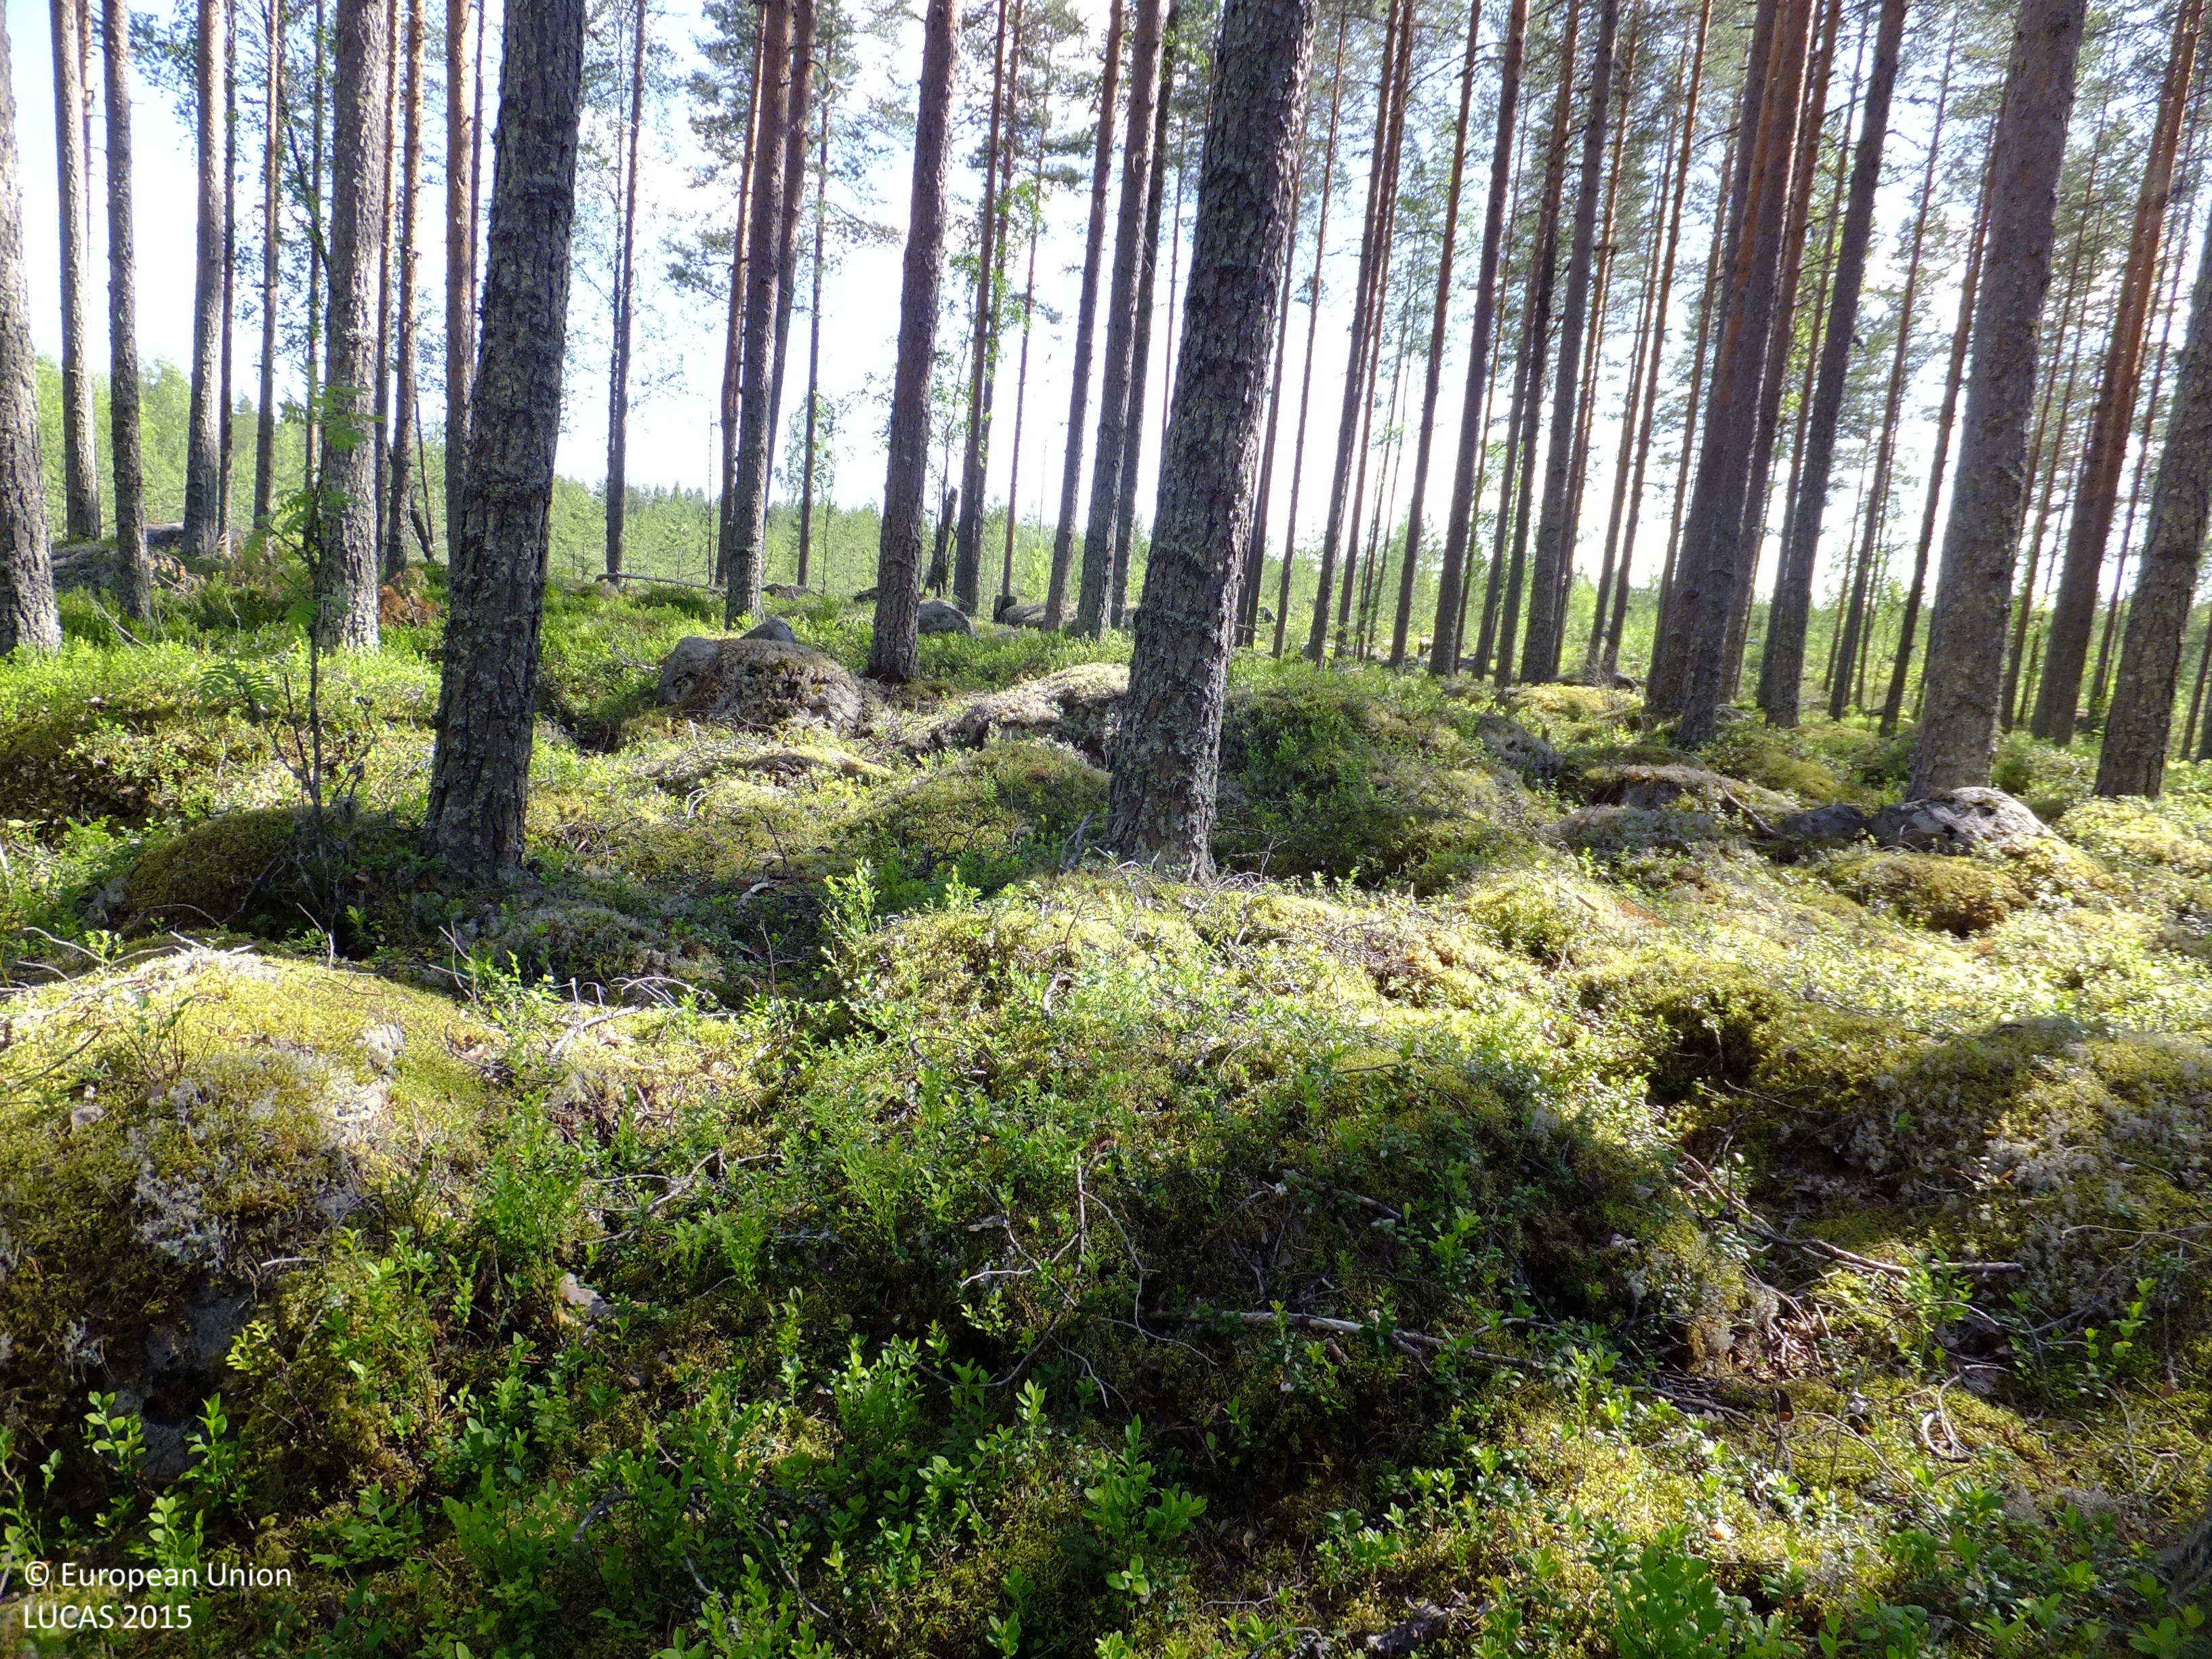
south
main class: Woodland
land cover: Pine dominated coniferous woodland
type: boreal forest
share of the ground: > 75 %
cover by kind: coniferous forest trees 80 %, broadleaved forest trees 5 %, shrubs 5 %, lichens and mosses 5 %, consolidated bare surface 5 %
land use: Forestry
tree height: > 5 m
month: July
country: FI
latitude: 63.3007
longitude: 24.9125
